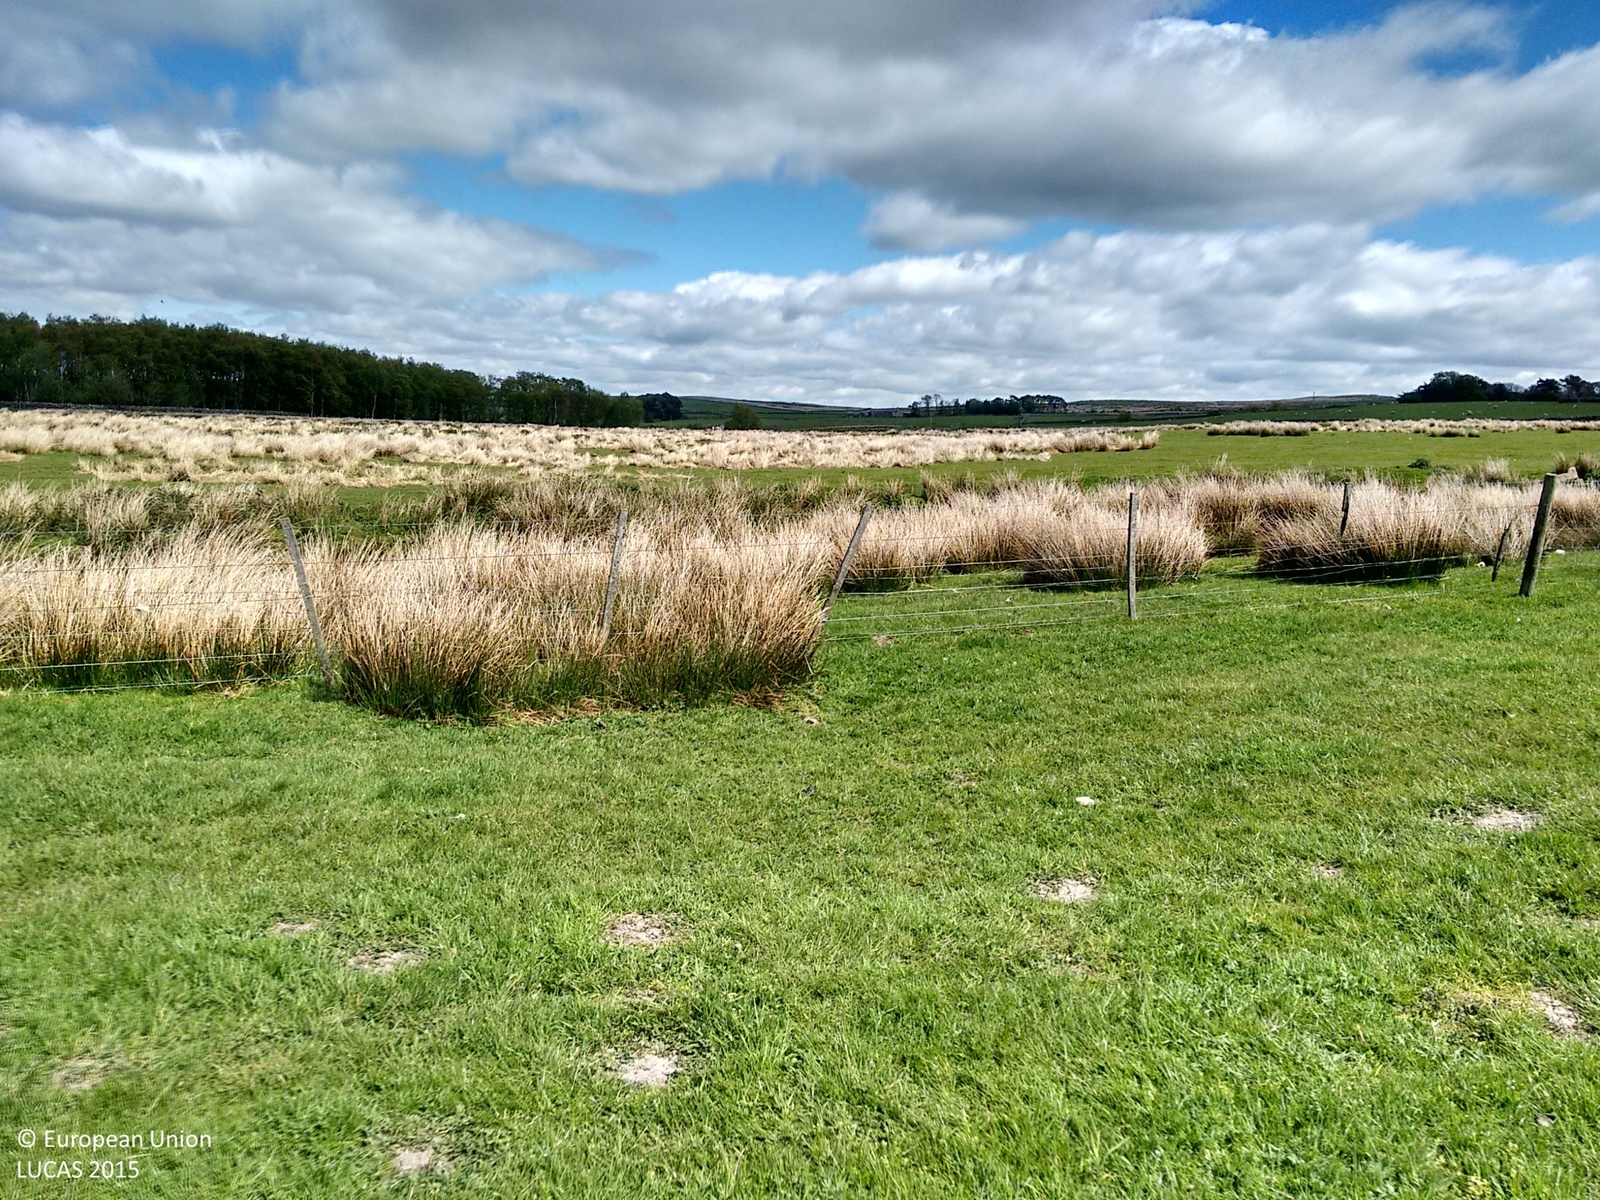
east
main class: Grassland
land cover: Grassland without tree/shrub cover
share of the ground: > 75 %
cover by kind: herbaceous plants 100 %
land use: Agriculture (excluding fallow land and kitchen gardens)
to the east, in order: Grassland without tree/shrub cover; Fences; Grassland without tree/shrub cover; Rivers and streams; Grassland without tree/shrub cover
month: May
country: GB
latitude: 54.9243
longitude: -2.4353
